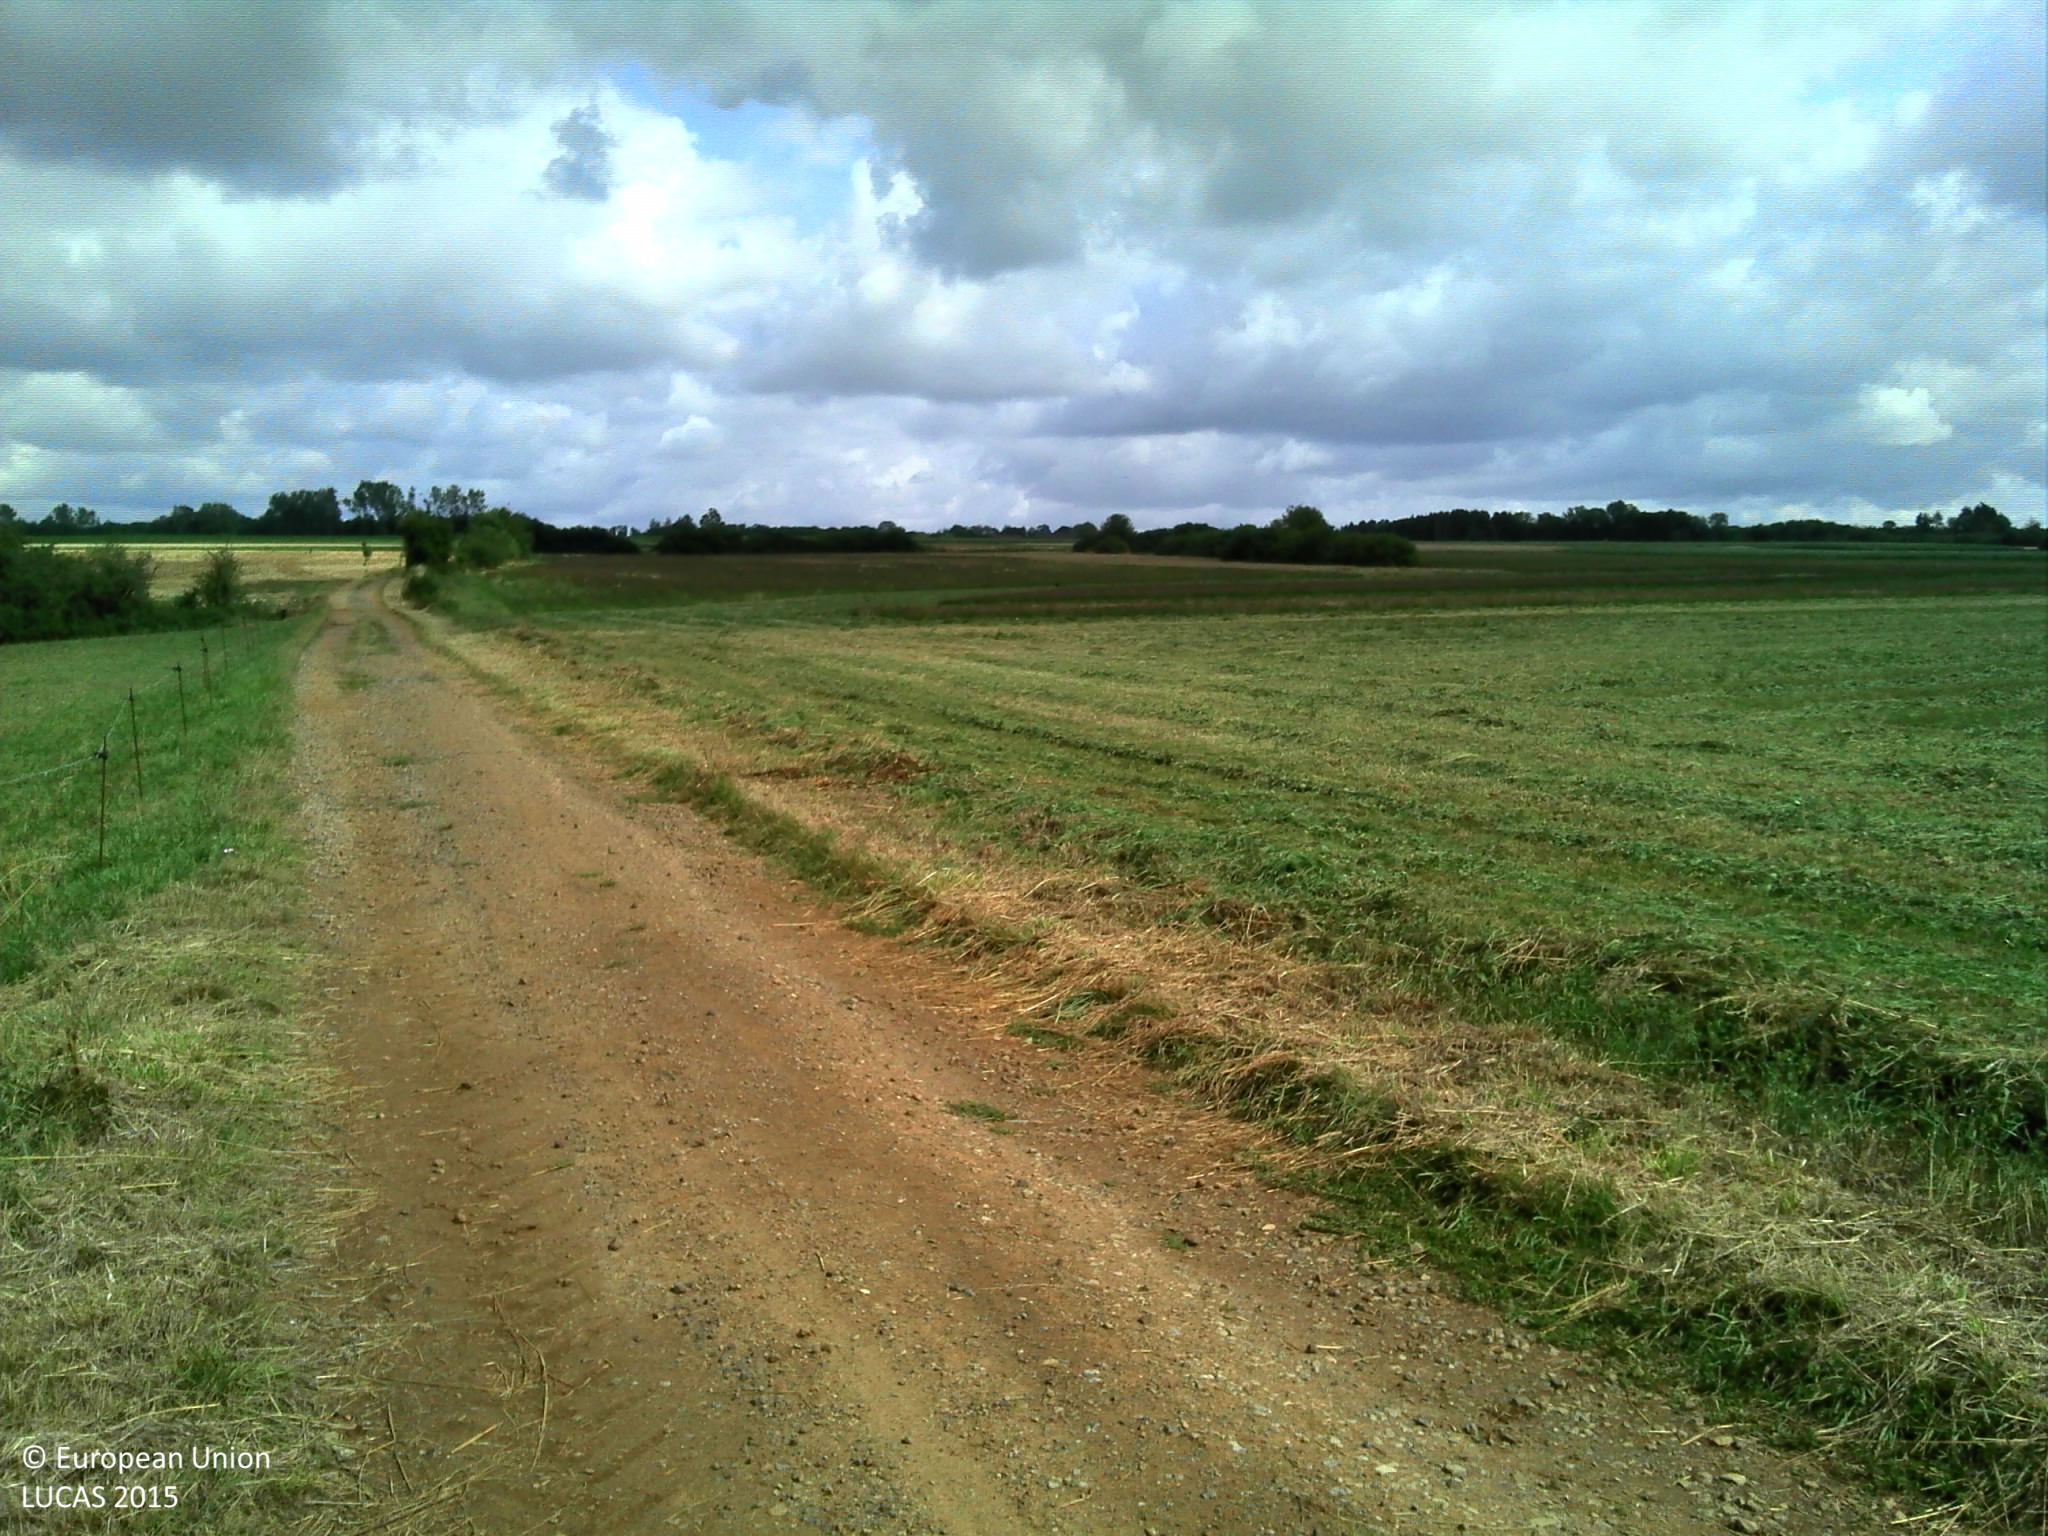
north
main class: Cropland
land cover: Temporary grasslands
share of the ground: > 75 %
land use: Agriculture (excluding fallow land and kitchen gardens)
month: July
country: BE
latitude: 49.5860
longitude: 5.8355
